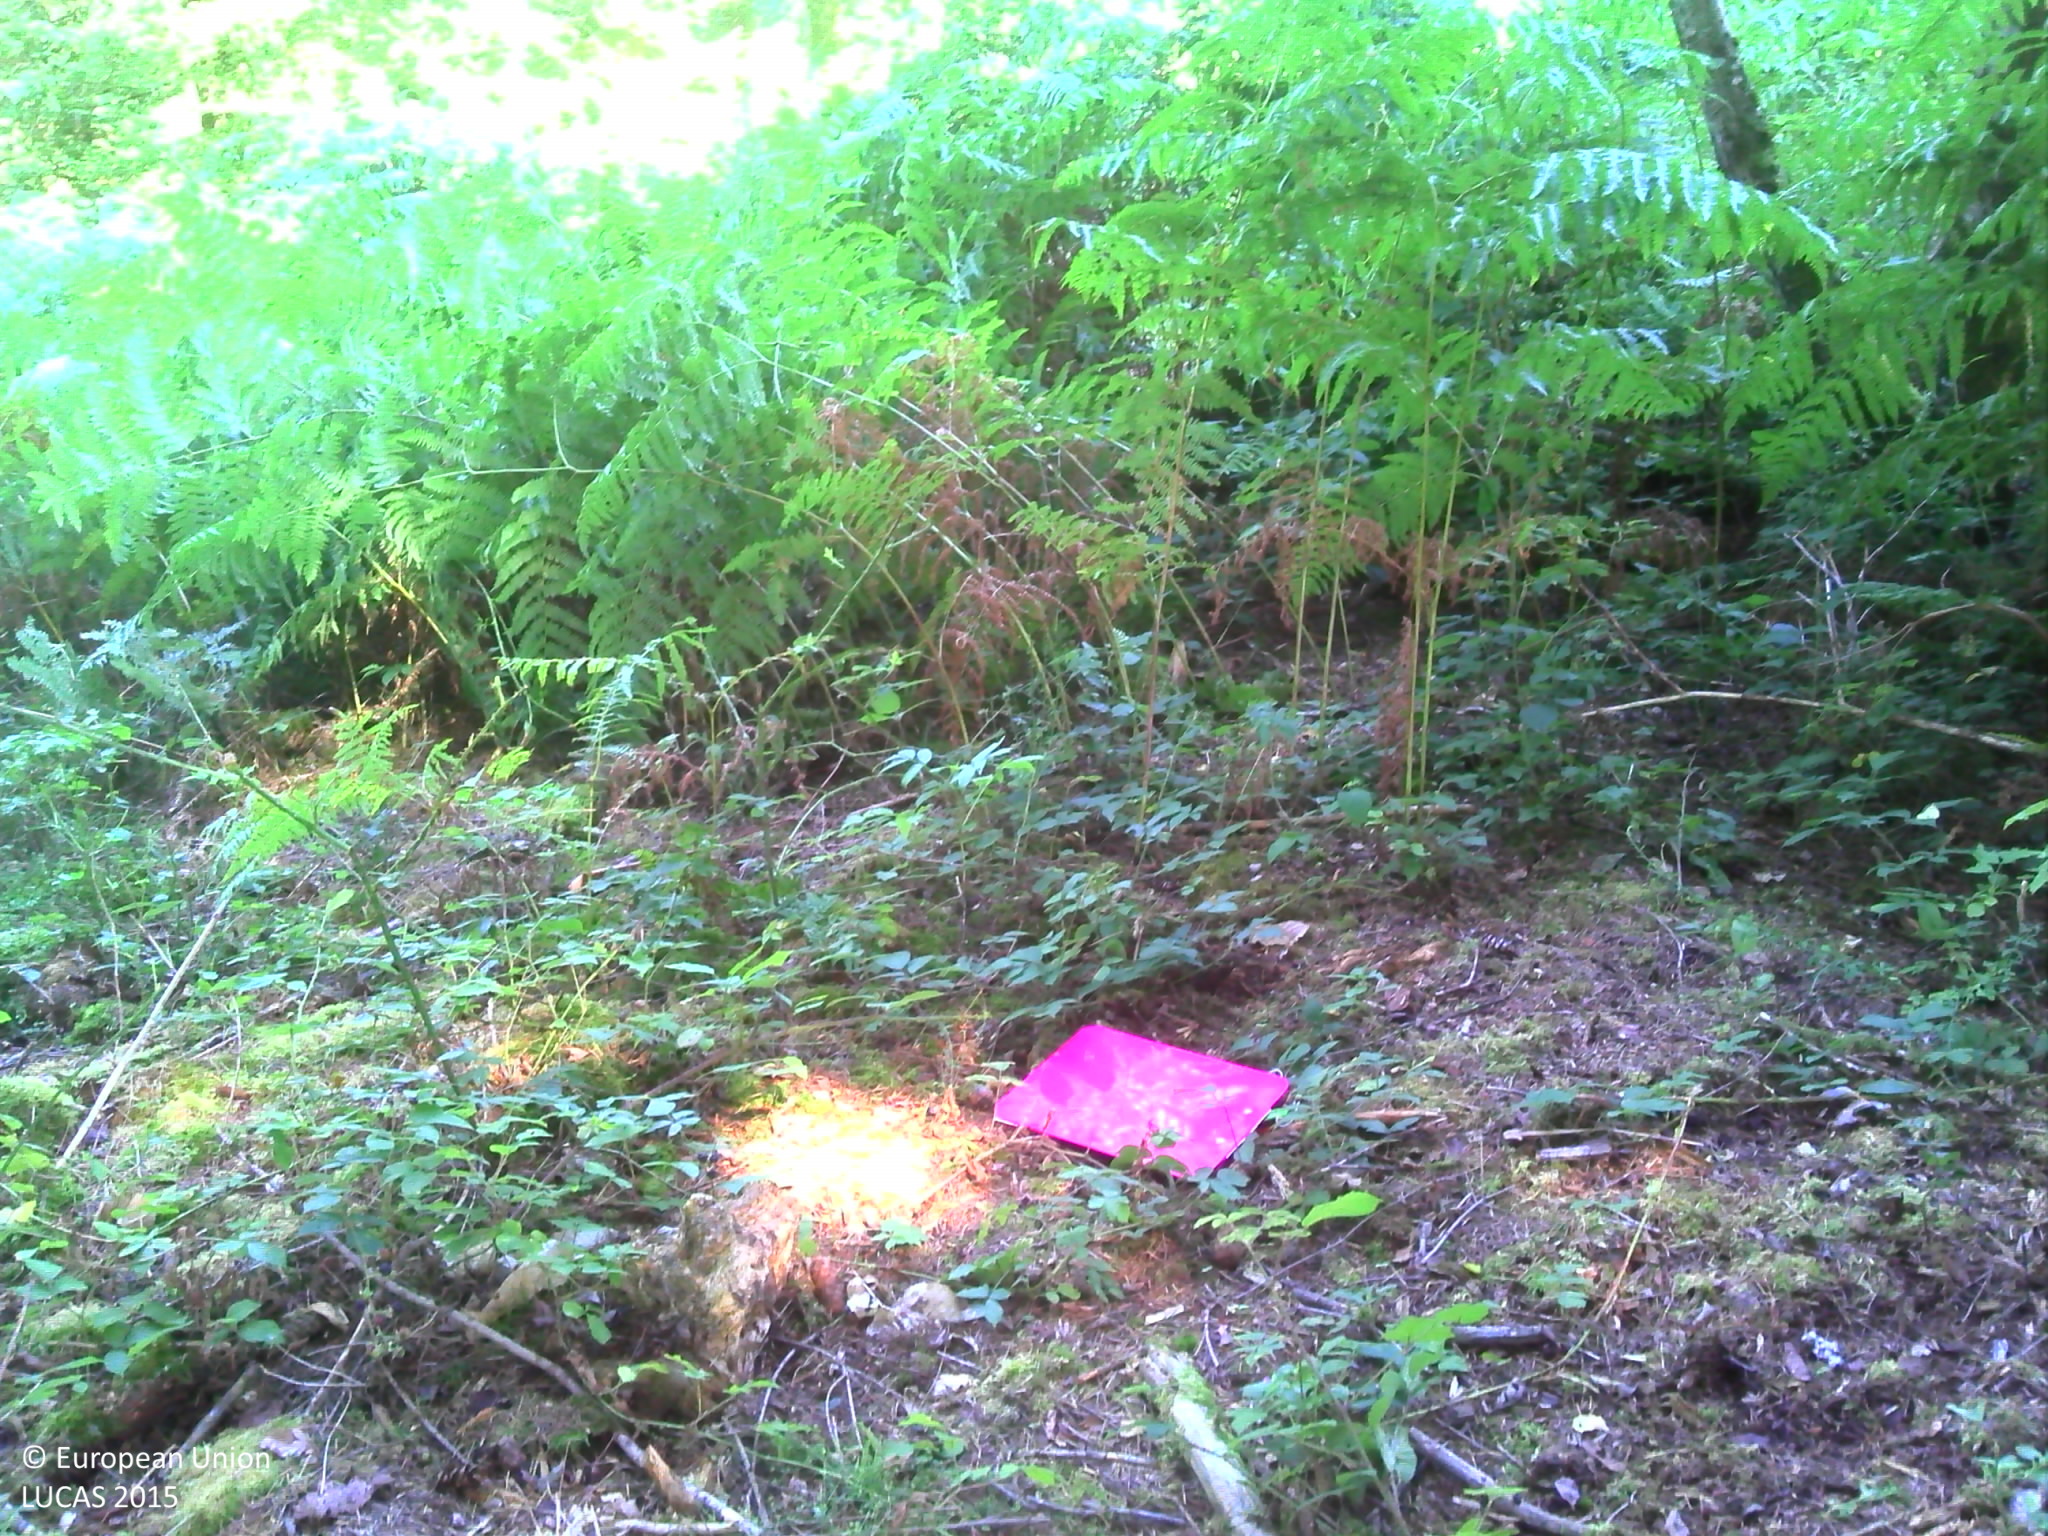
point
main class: Woodland
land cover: Spruce dominated coniferous woodland
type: hemiboreal forest and nemoral coniferous forest and mixed broadleaved-coniferous forest
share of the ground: > 75 %
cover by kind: coniferous forest trees 95 %, broadleaved forest trees 5 %
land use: Semi-natural and natural areas not in use
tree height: > 5 m
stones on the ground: < 10 %
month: August
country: FR
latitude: 46.0046
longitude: 1.4035
